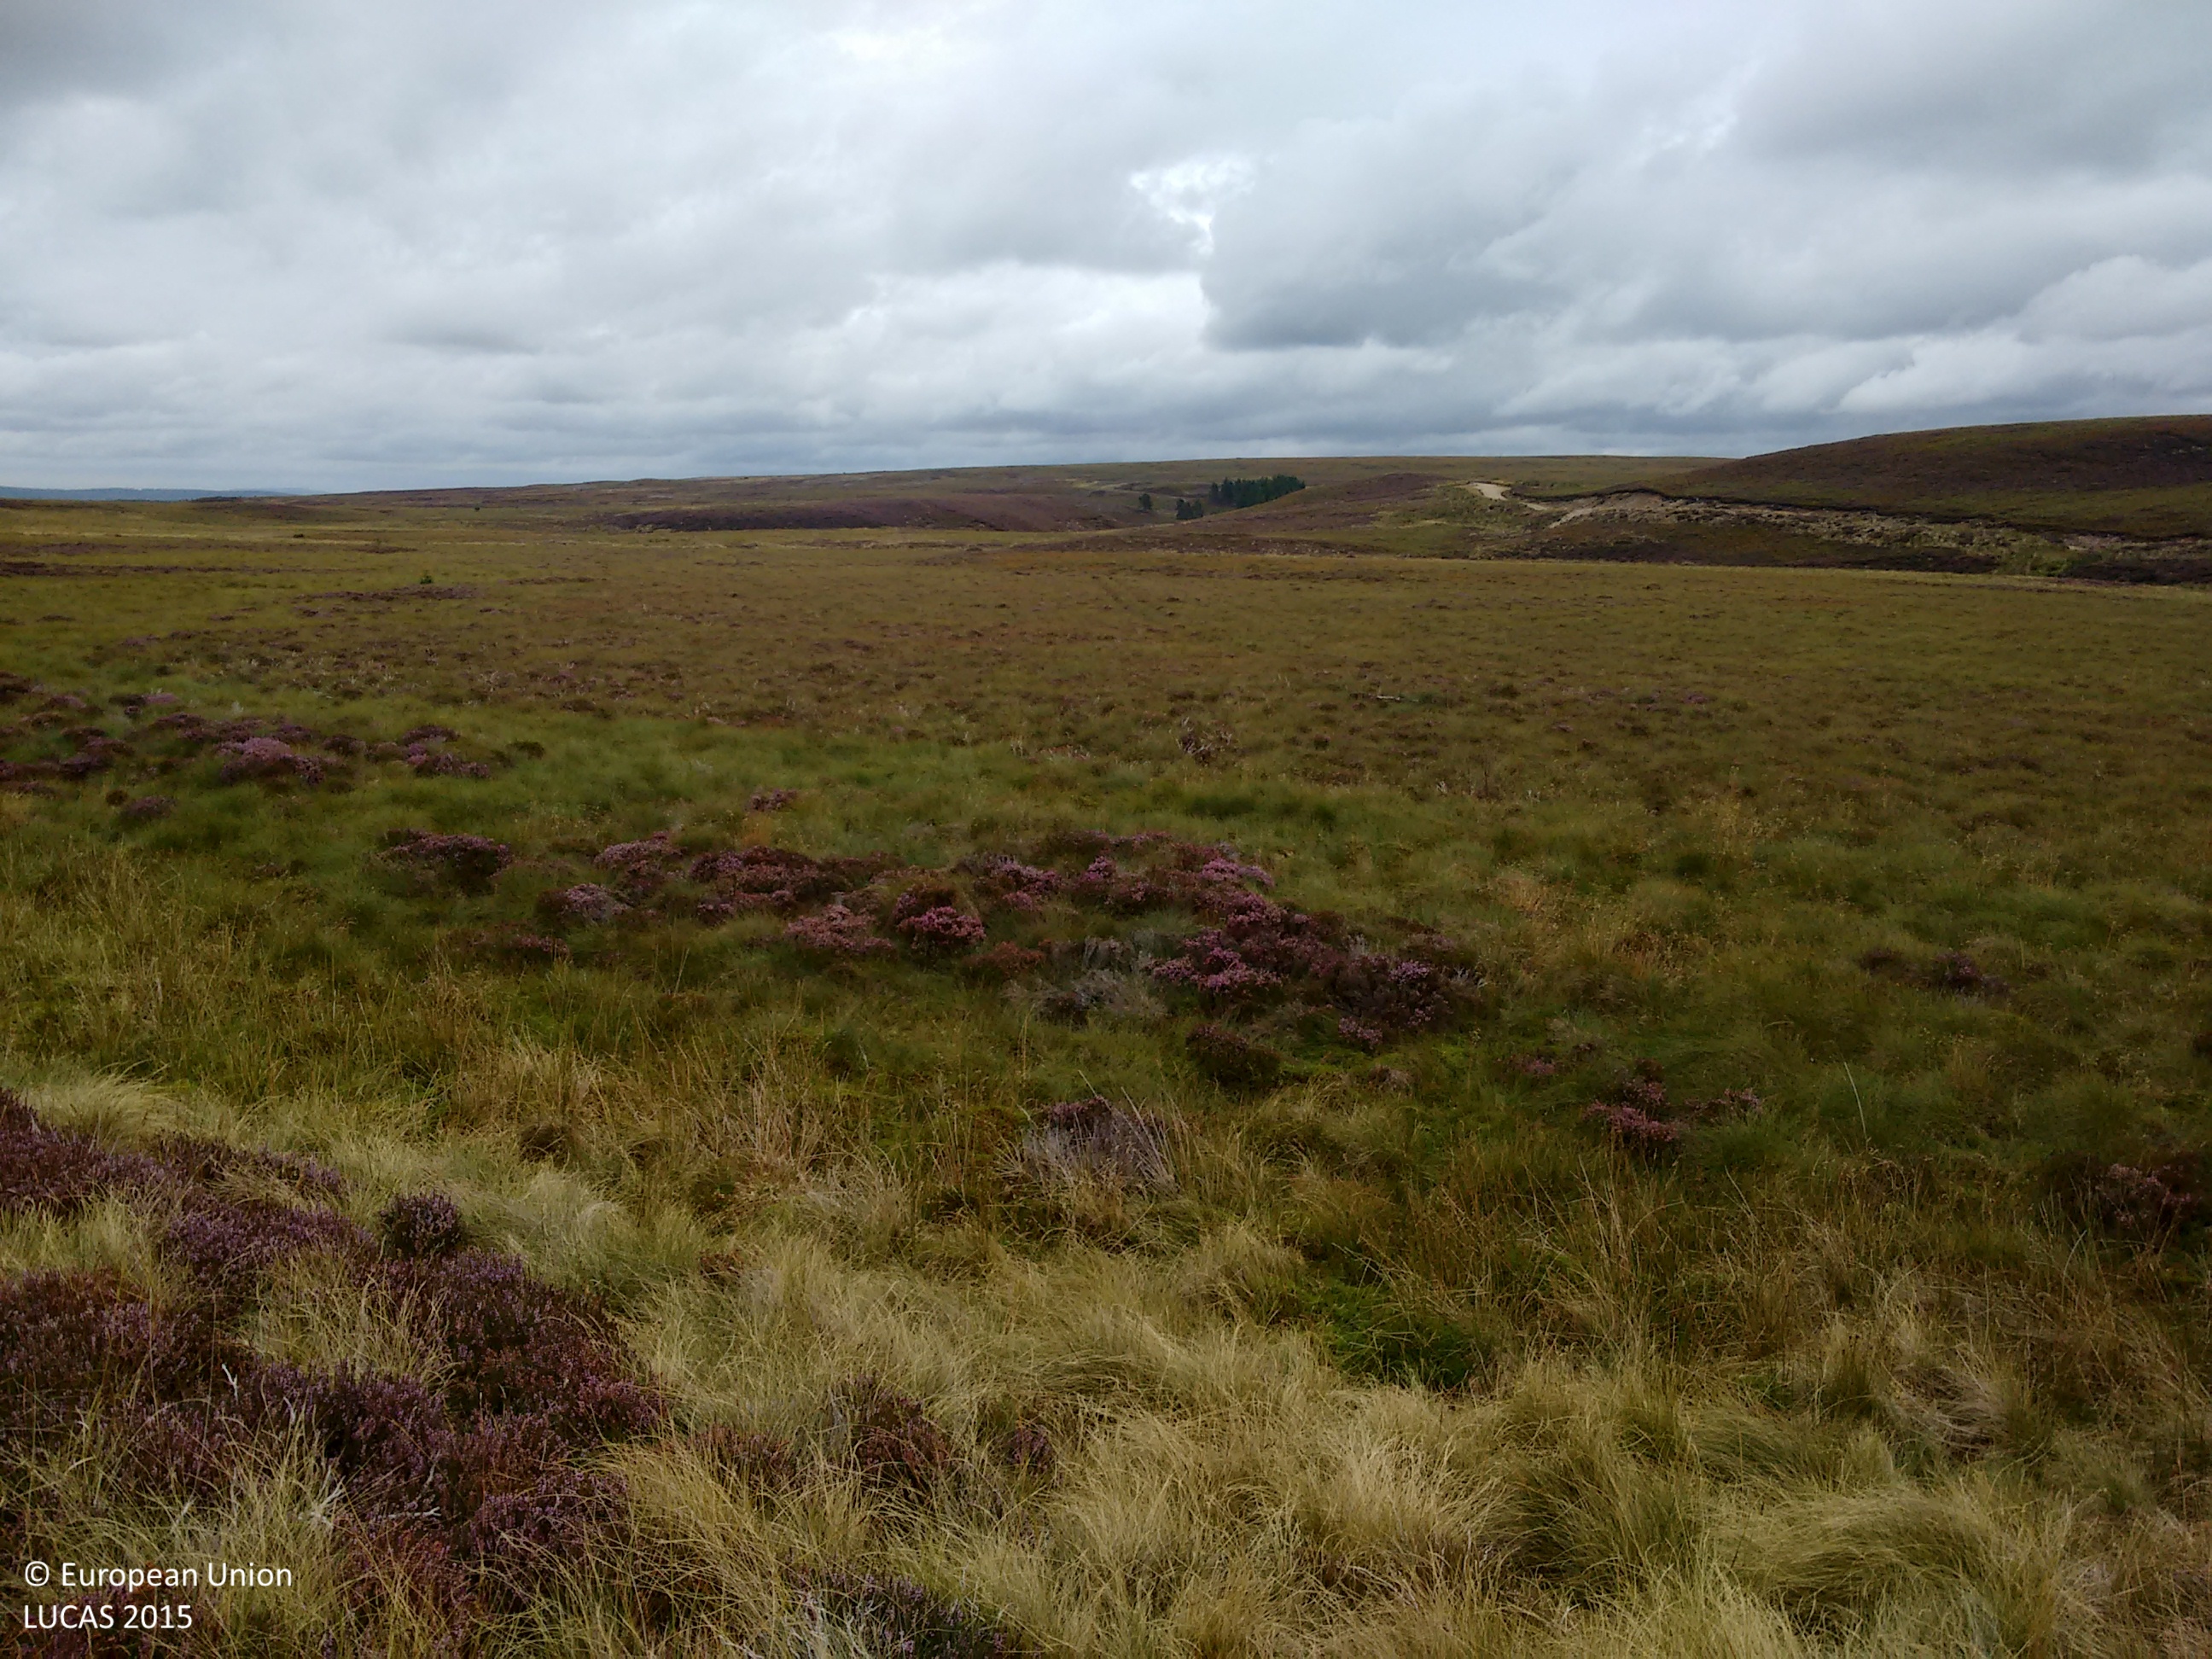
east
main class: Shrubland
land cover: Shrubland without tree cover
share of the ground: > 75 %
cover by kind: shrubs 80 %, herbaceous plants 20 %
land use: Agriculture (excluding fallow land and kitchen gardens)
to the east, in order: Shrubland without tree cover
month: September
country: GB
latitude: 57.4562
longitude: -3.8955
